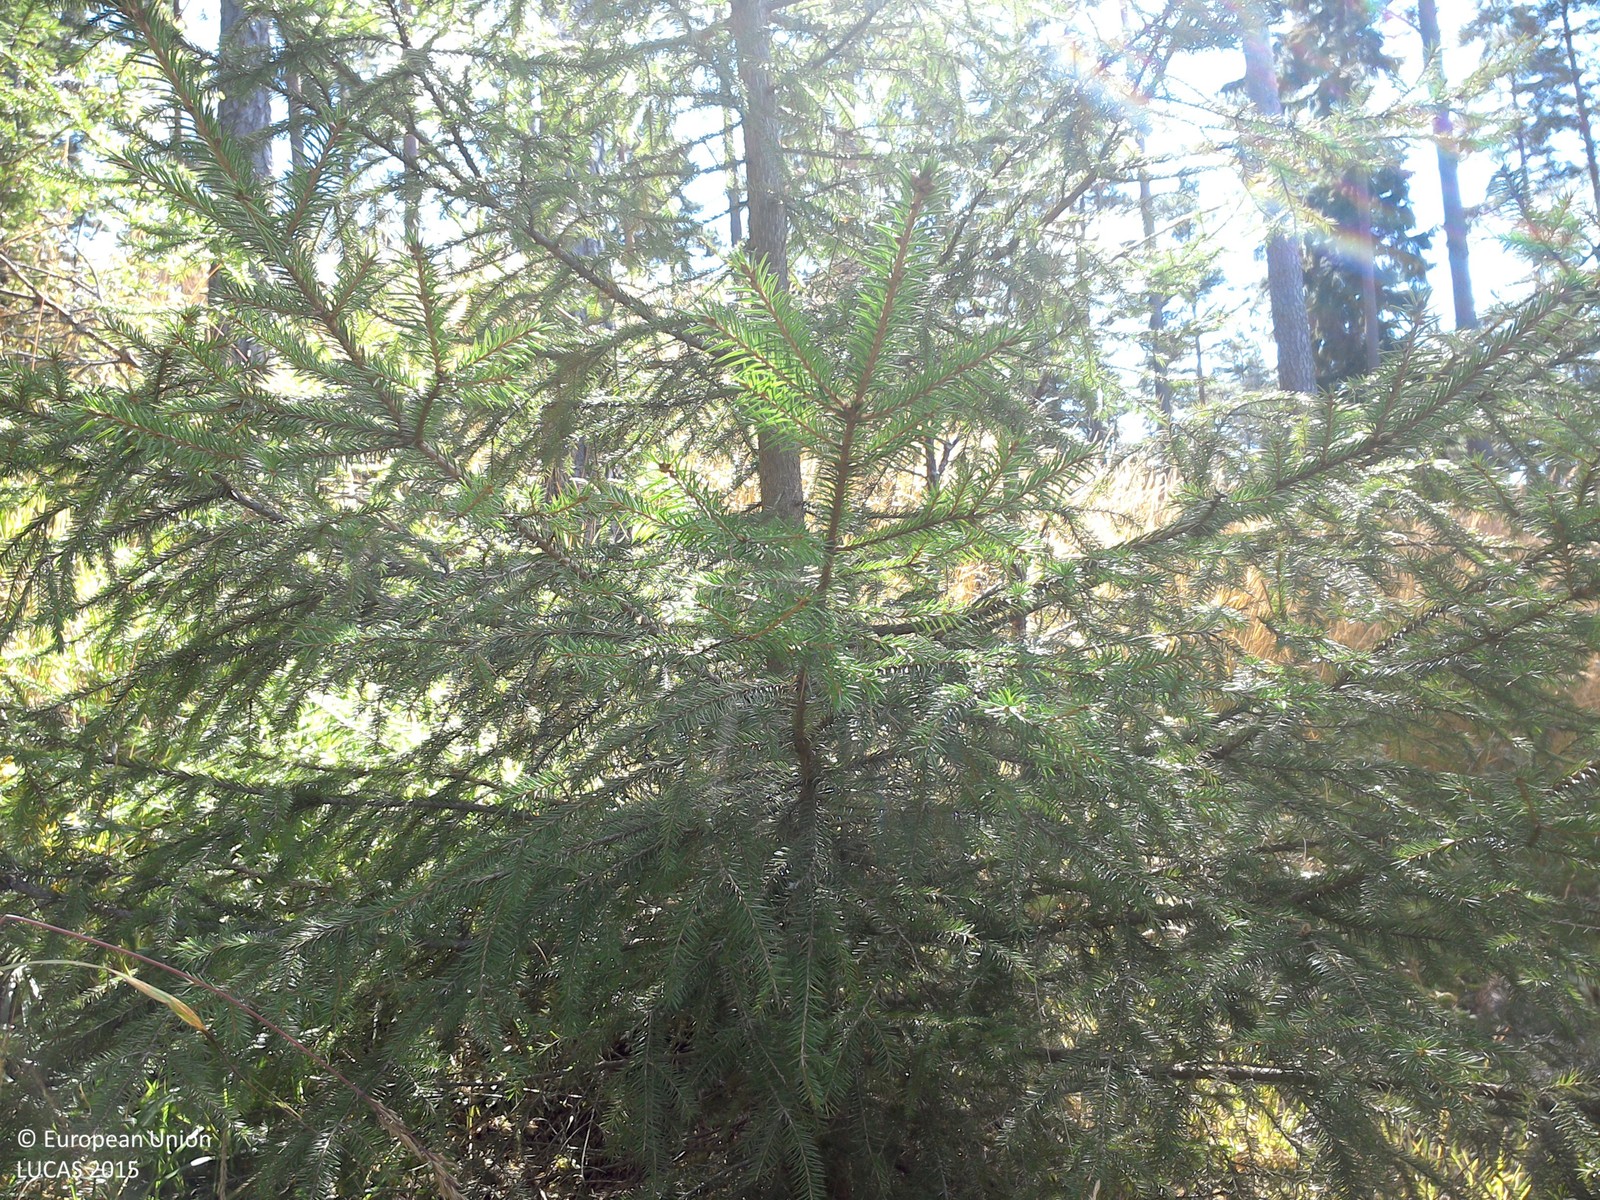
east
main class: Woodland
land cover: Spruce dominated mixed woodland
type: boreal forest
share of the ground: 50 - 75 %
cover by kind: coniferous forest trees 50 %, broadleaved forest trees 20 %, herbaceous plants 15 %, lichens and mosses 15 %
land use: Forestry
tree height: < 5 m
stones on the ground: < 10 %
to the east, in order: Spruce dominated mixed woodland; Pine dominated mixed woodland; Spruce dominated mixed woodland
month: August
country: SE
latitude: 58.0982
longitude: 15.2713
